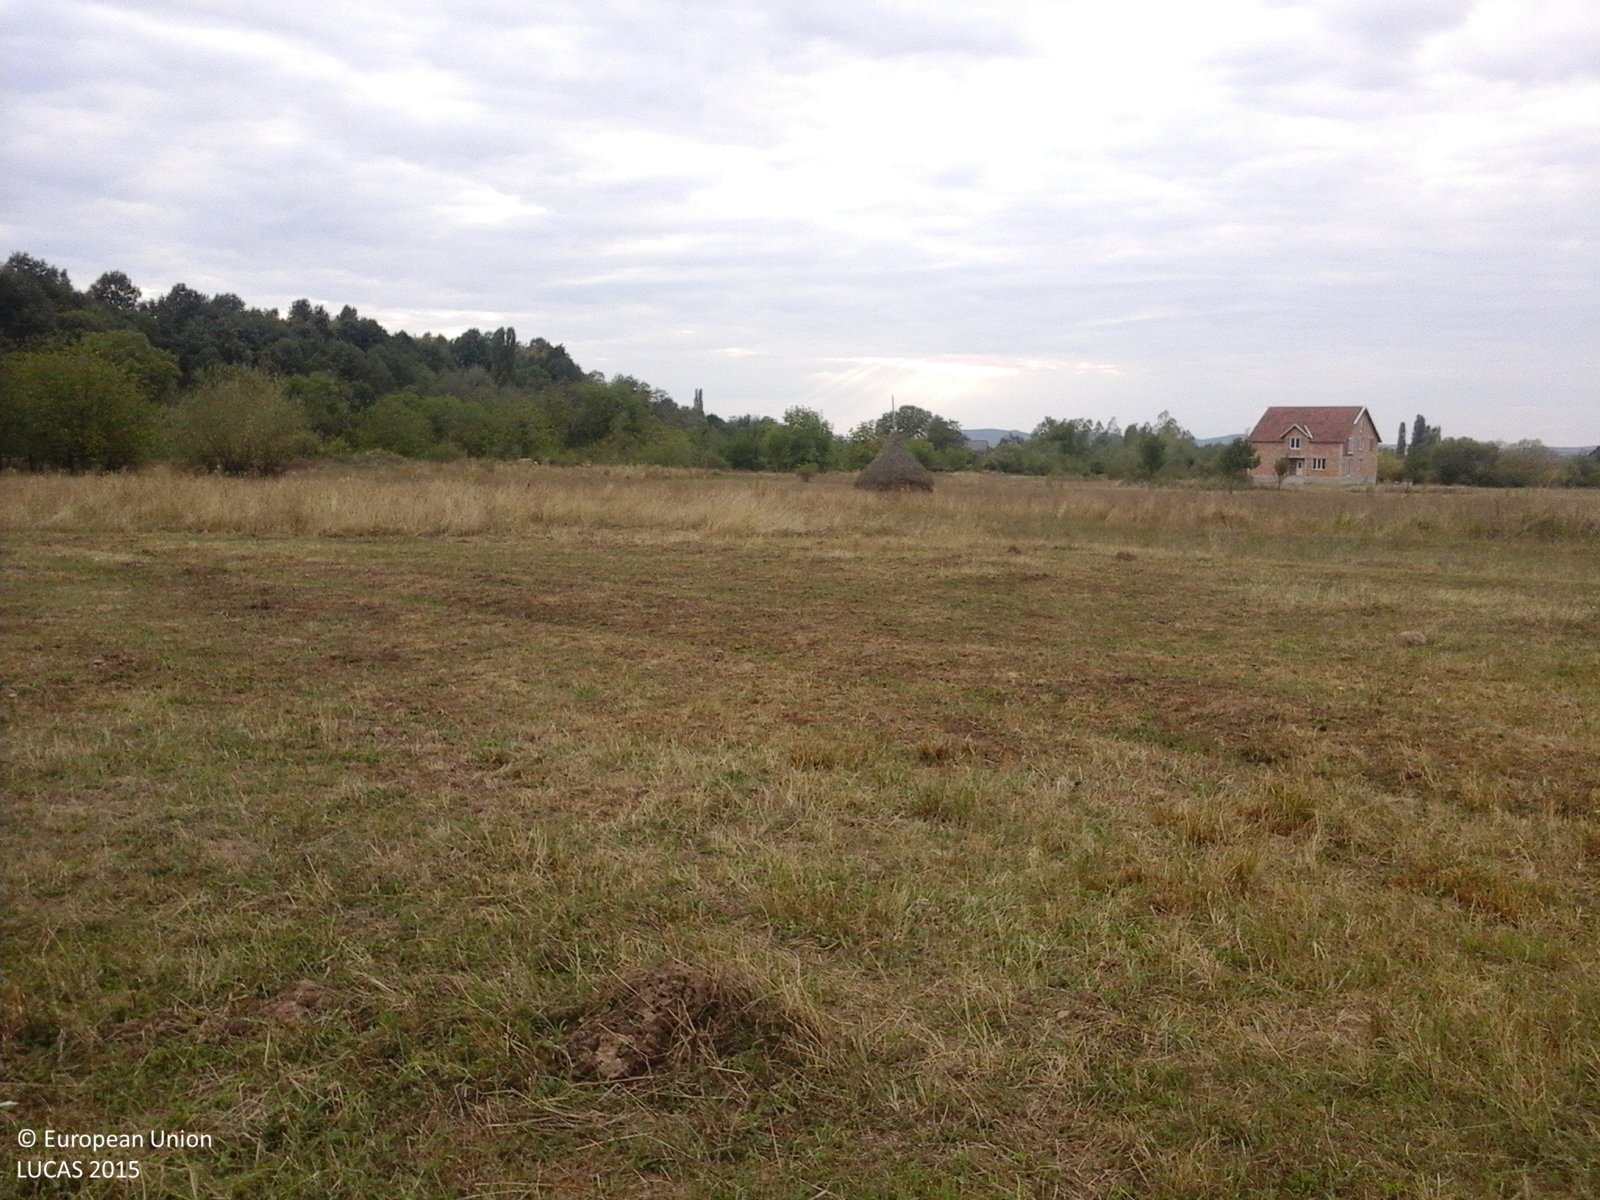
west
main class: Grassland
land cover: Grassland without tree/shrub cover
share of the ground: > 75 %
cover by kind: herbaceous plants 100 %
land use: Agriculture (excluding fallow land and kitchen gardens)
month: September
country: RO
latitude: 47.8536
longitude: 23.4260
